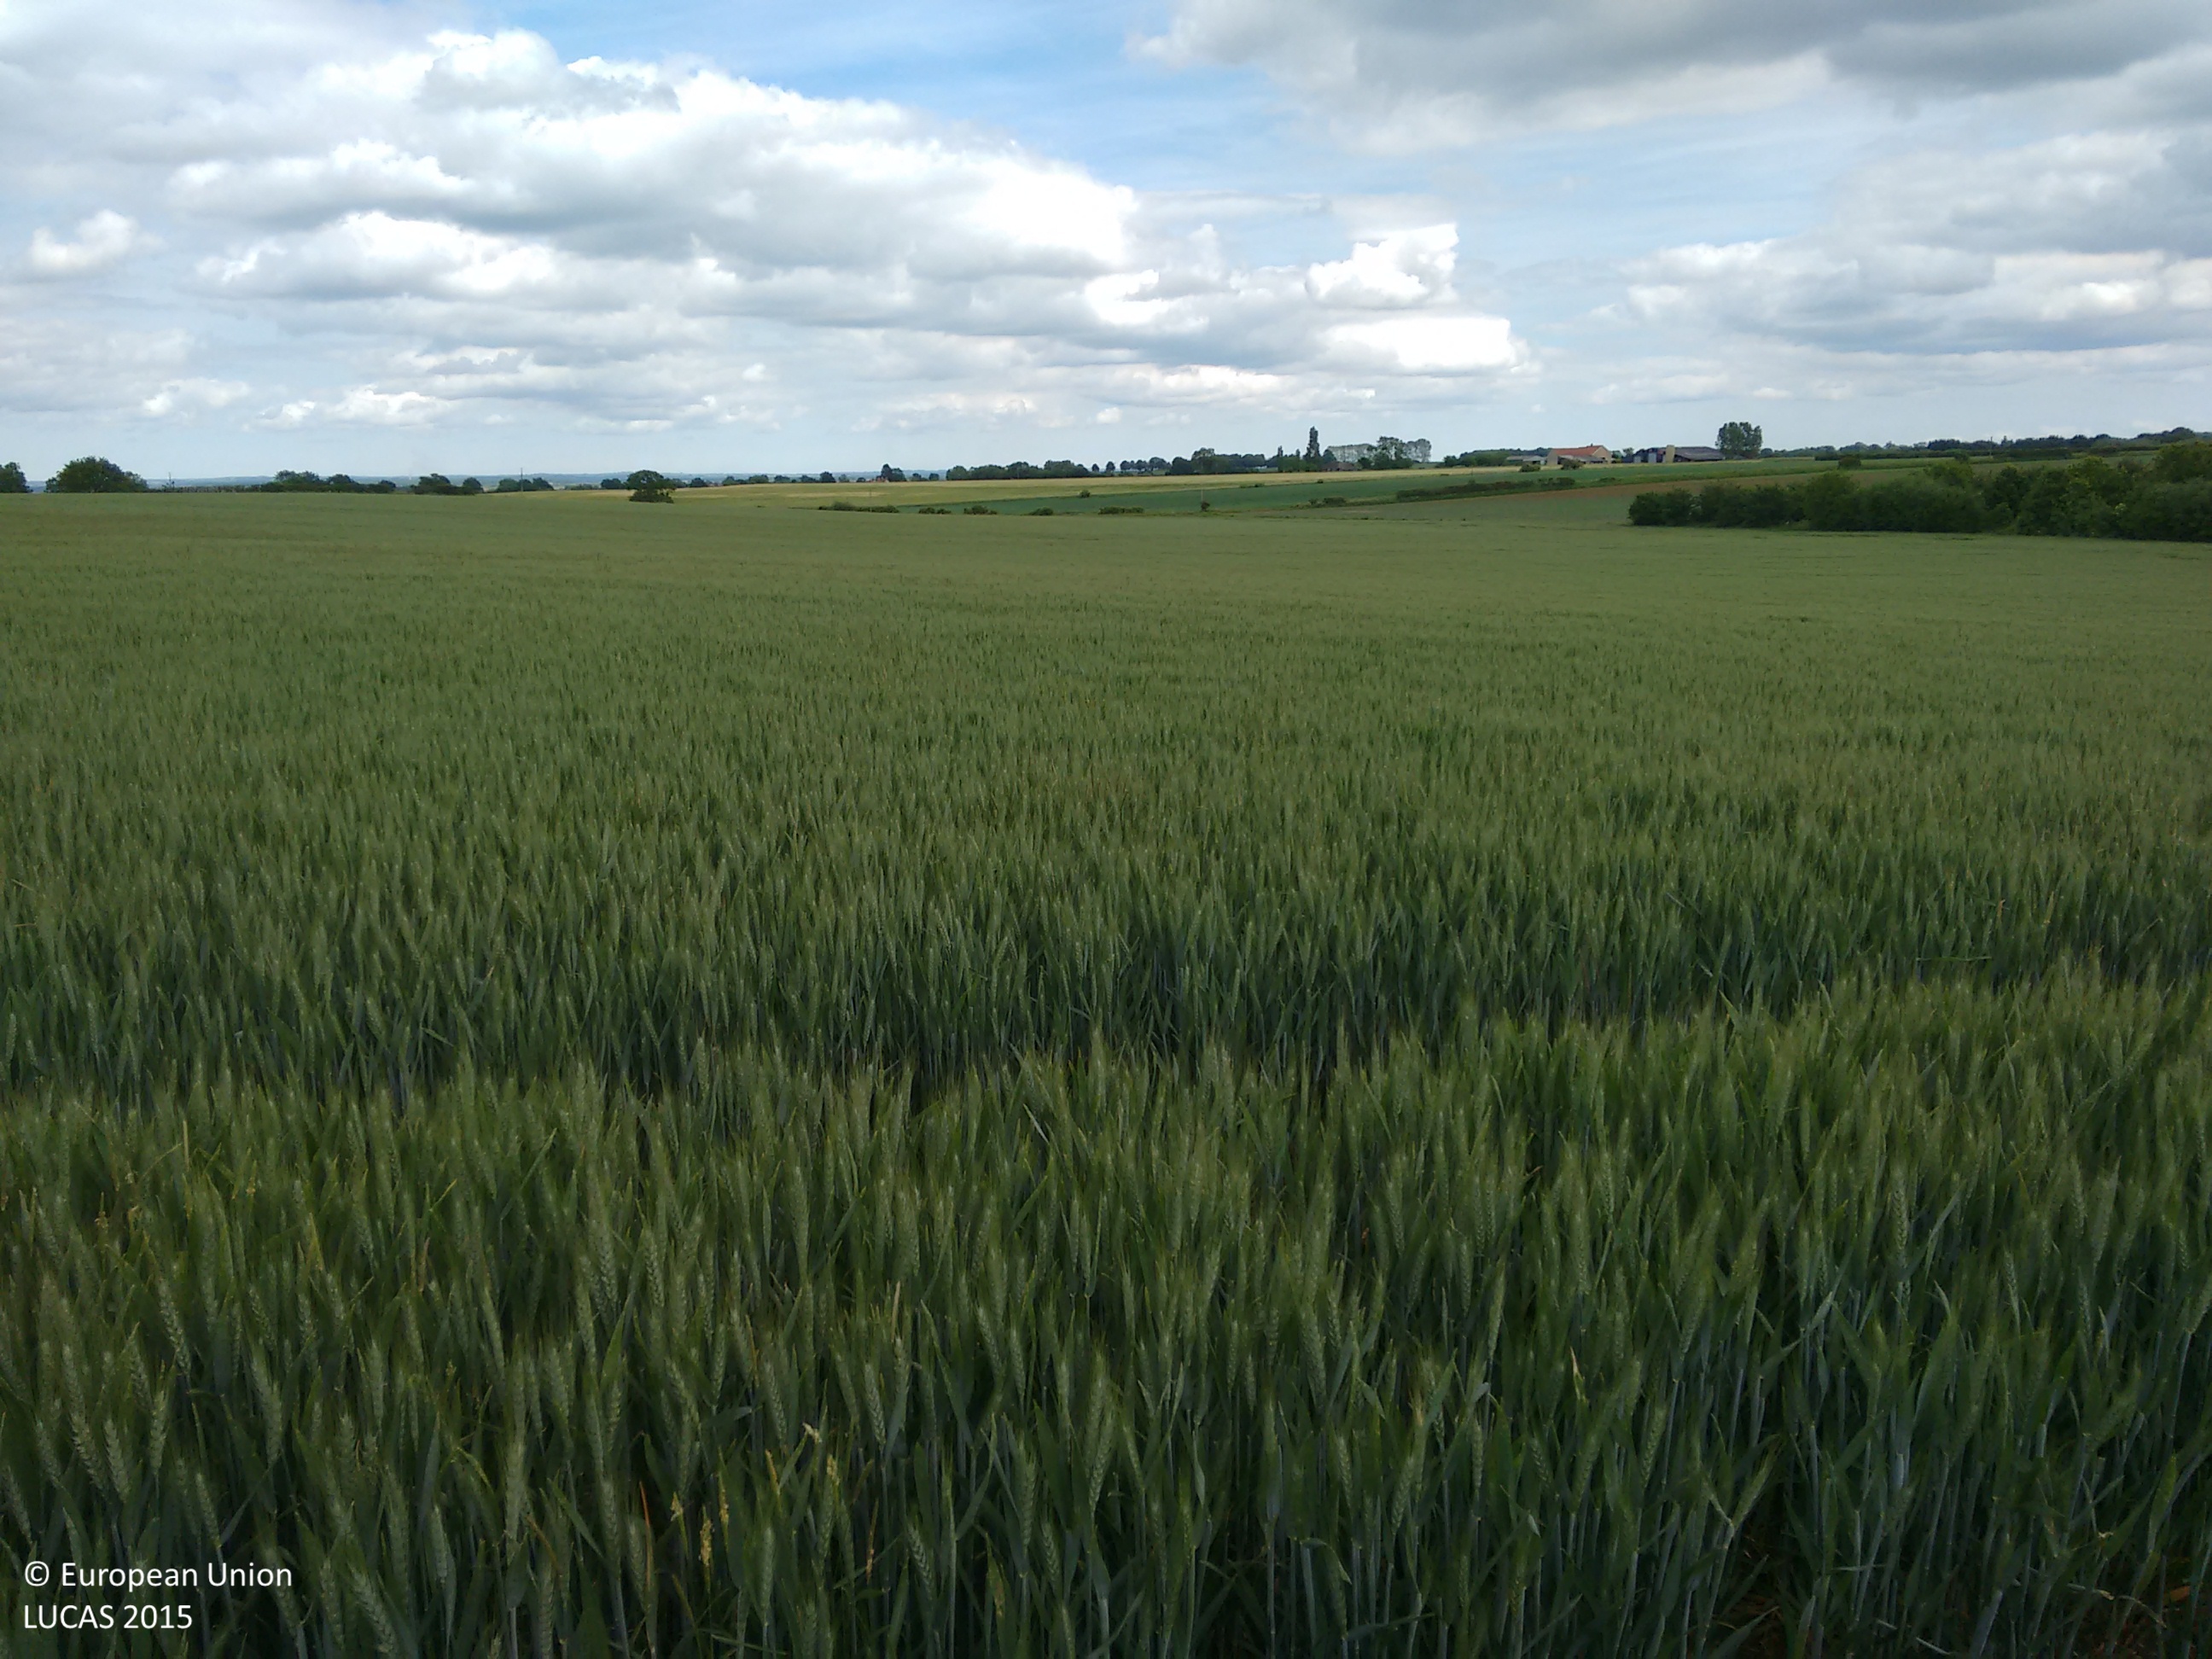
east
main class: Cropland
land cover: Common wheat
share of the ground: > 75 %
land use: Agriculture (excluding fallow land and kitchen gardens)
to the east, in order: Common wheat
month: June
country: GB
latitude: 53.2031
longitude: -0.4417
